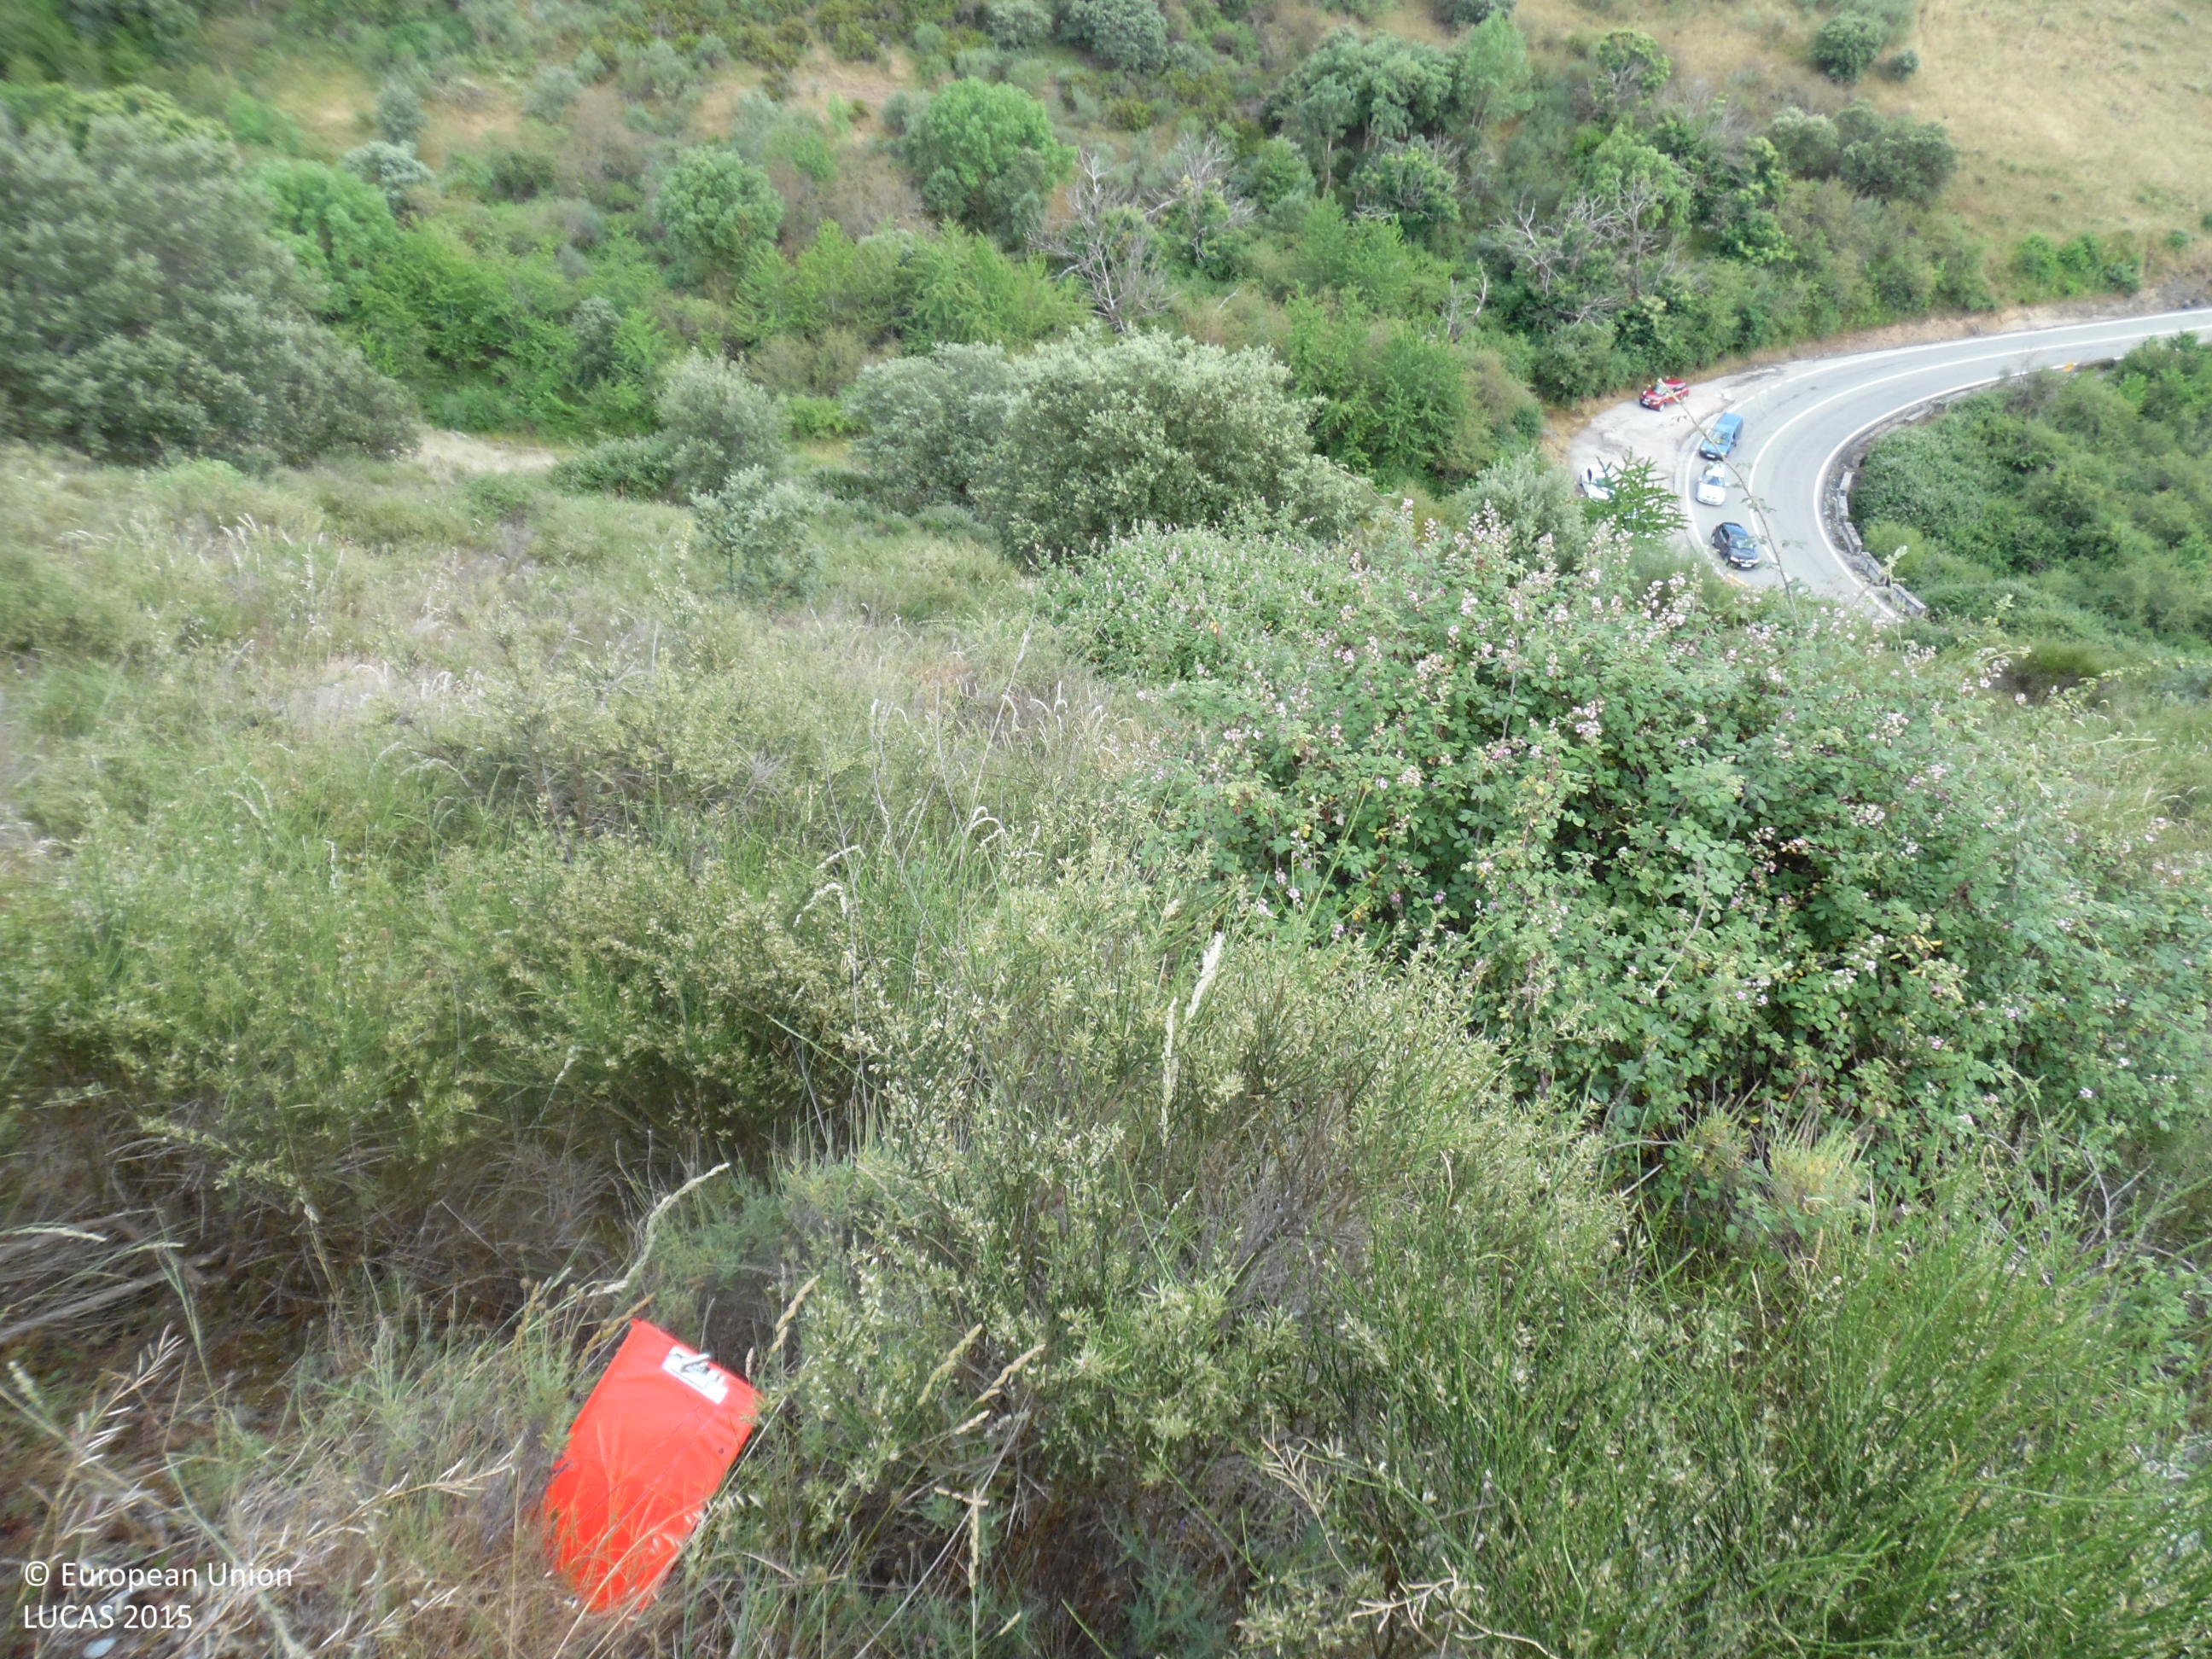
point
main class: Shrubland
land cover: Shrubland with sparse tree cover
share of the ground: > 75 %
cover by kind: shrubs 95 %, broadleaved forest trees 5 %
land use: Abandoned areas
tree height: < 5 m
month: June
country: ES
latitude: 42.4507
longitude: -6.8180
